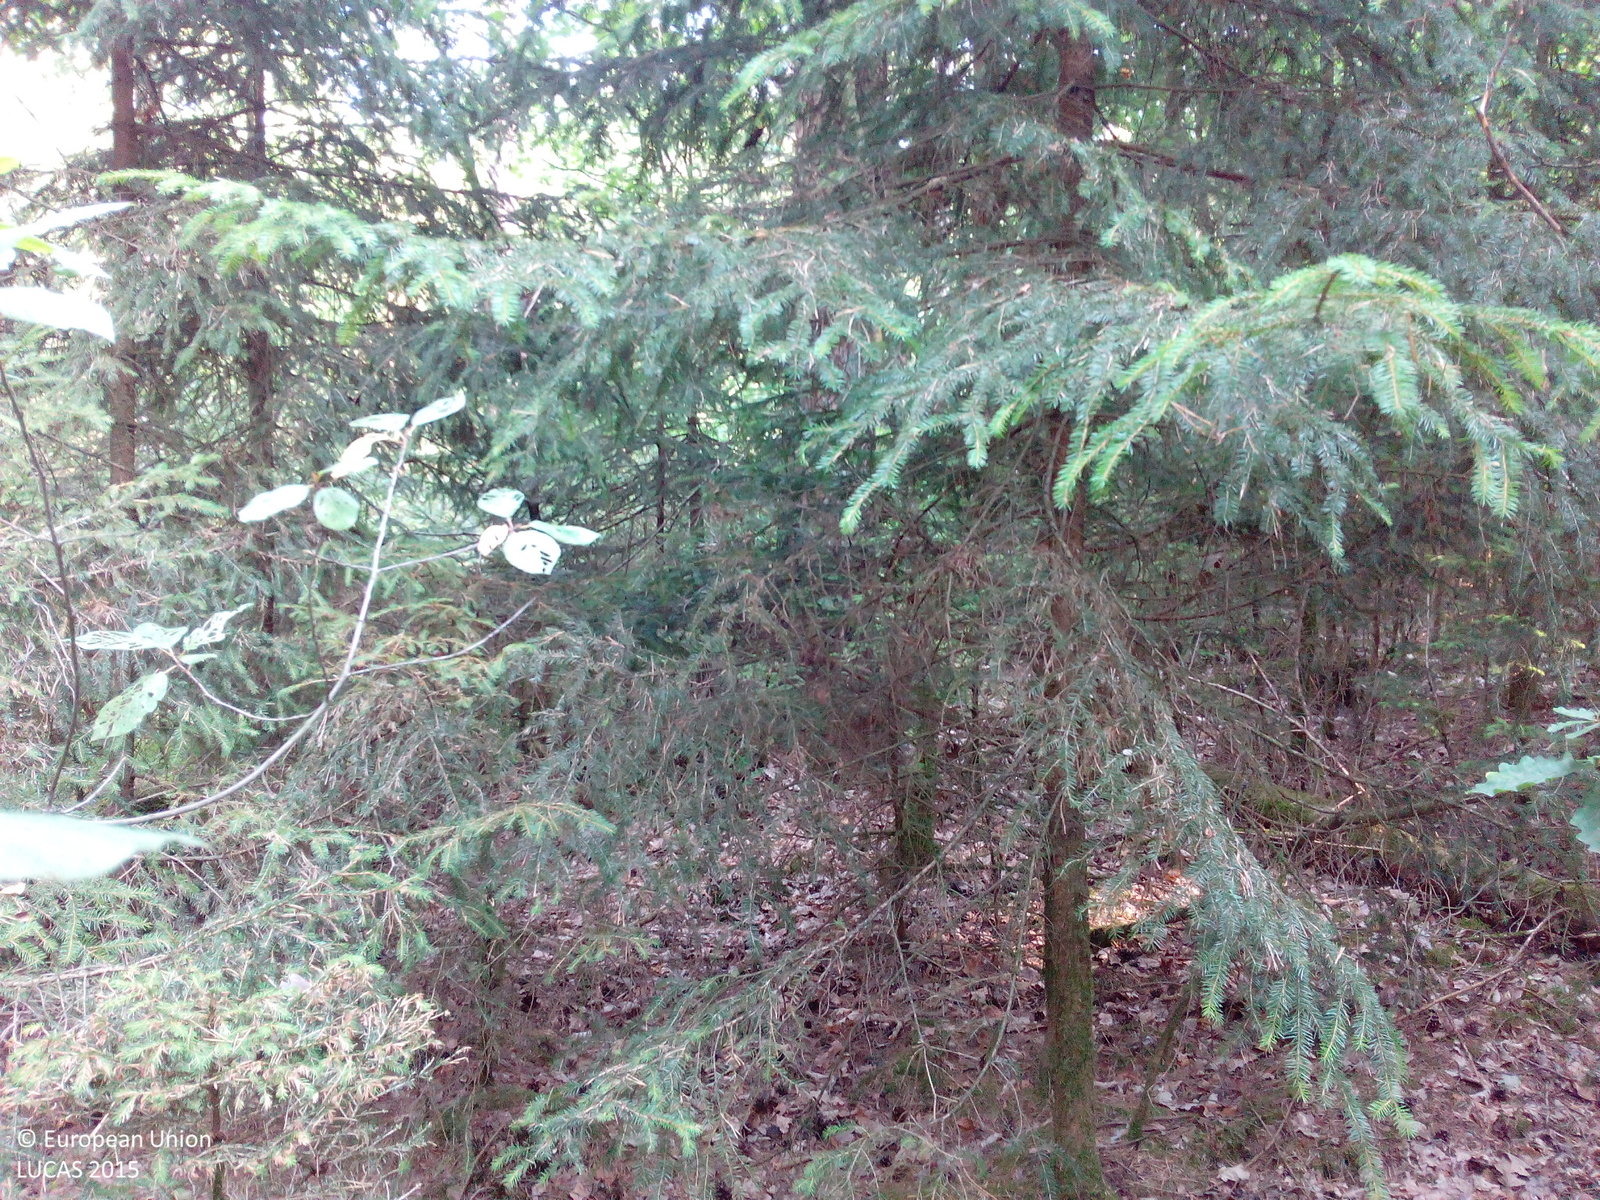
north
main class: Woodland
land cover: Spruce dominated coniferous woodland
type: hemiboreal forest and nemoral coniferous forest and mixed broadleaved-coniferous forest
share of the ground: > 75 %
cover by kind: coniferous forest trees 80 %, lichens and mosses 10 %, broadleaved forest trees 5 %, shrubs 5 %
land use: Forestry
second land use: Amenities, museums, leisure
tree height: > 5 m
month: August
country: DE
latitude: 50.0830
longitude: 11.6067
